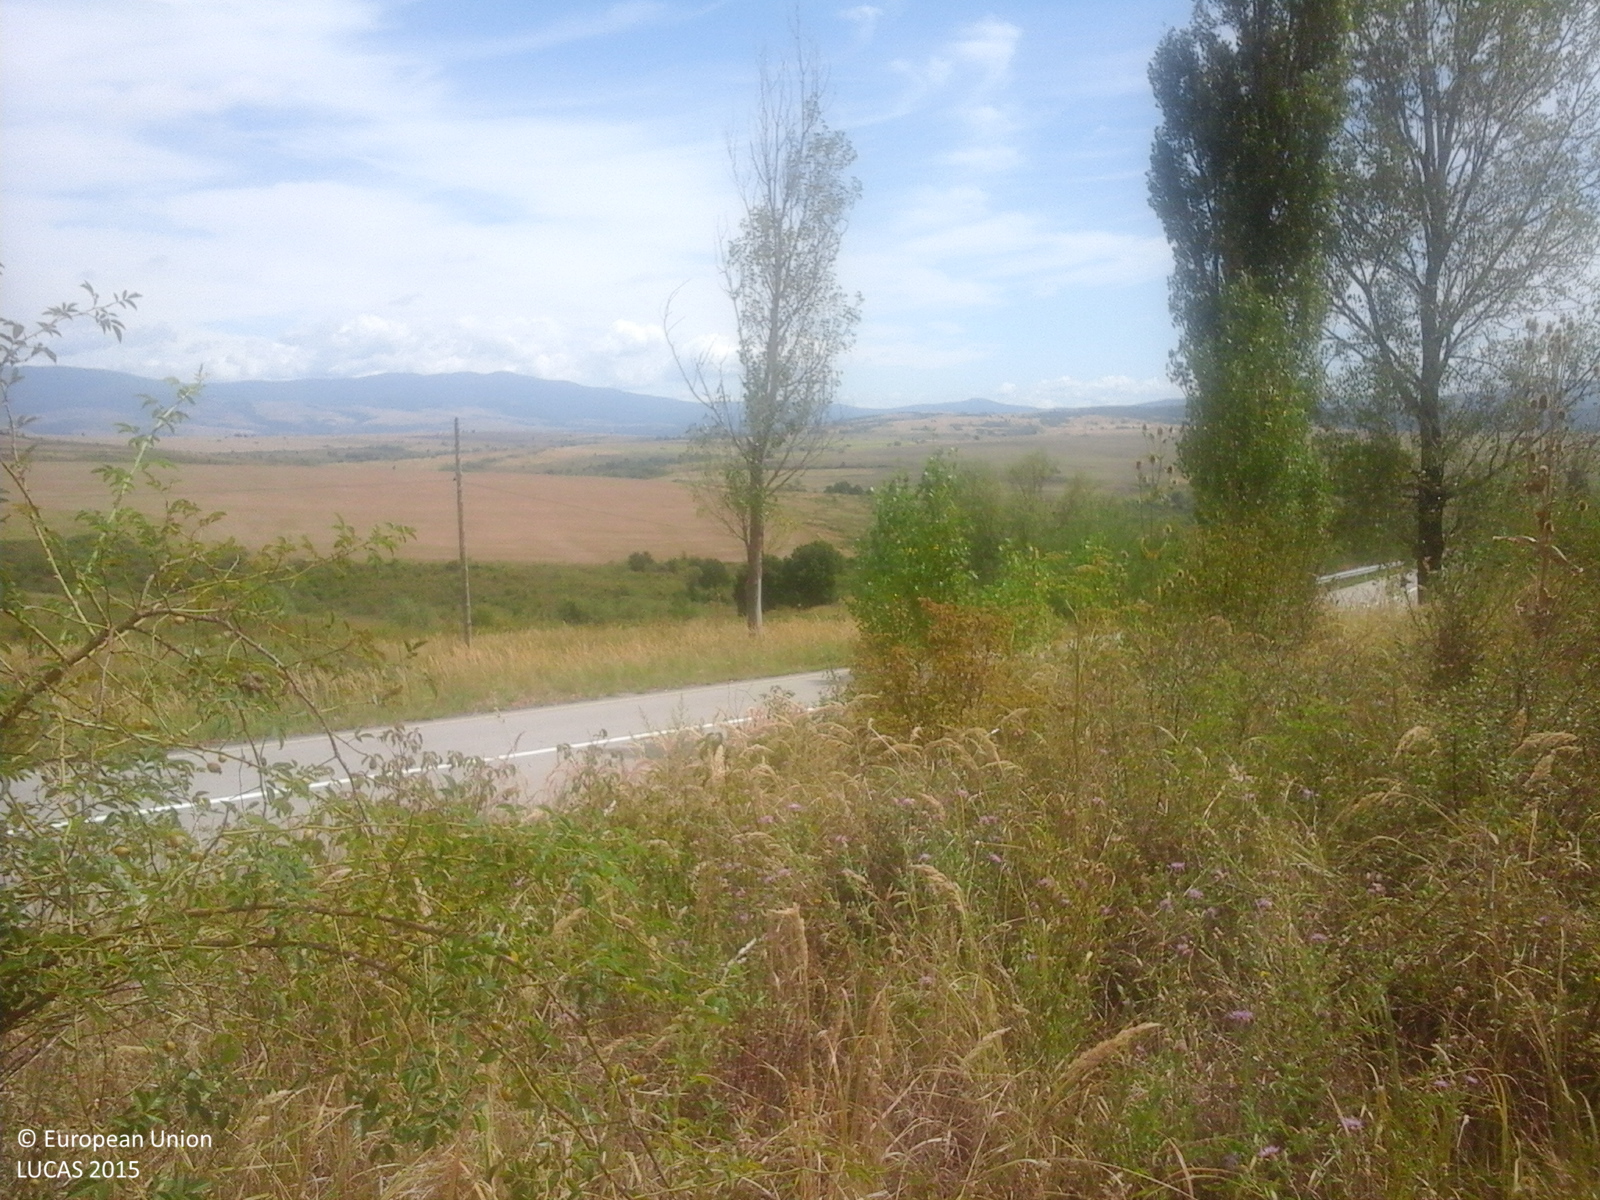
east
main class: Grassland
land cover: Spontaneously vegetated surfaces
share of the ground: > 75 %
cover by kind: herbaceous plants 100 %
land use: Fallow land
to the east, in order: Spontaneously vegetated surfaces; Lines of trees; Ditches and canals; Paved roads, cycling and walking lanes; Ditches and canals; Lines of trees; Spontaneously vegetated surfaces; Electric lines; Spontaneously vegetated surfaces; Shrubland with sparse tree cover; Spontaneously vegetated surfaces
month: August
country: RO
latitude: 44.9205
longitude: 21.5704
